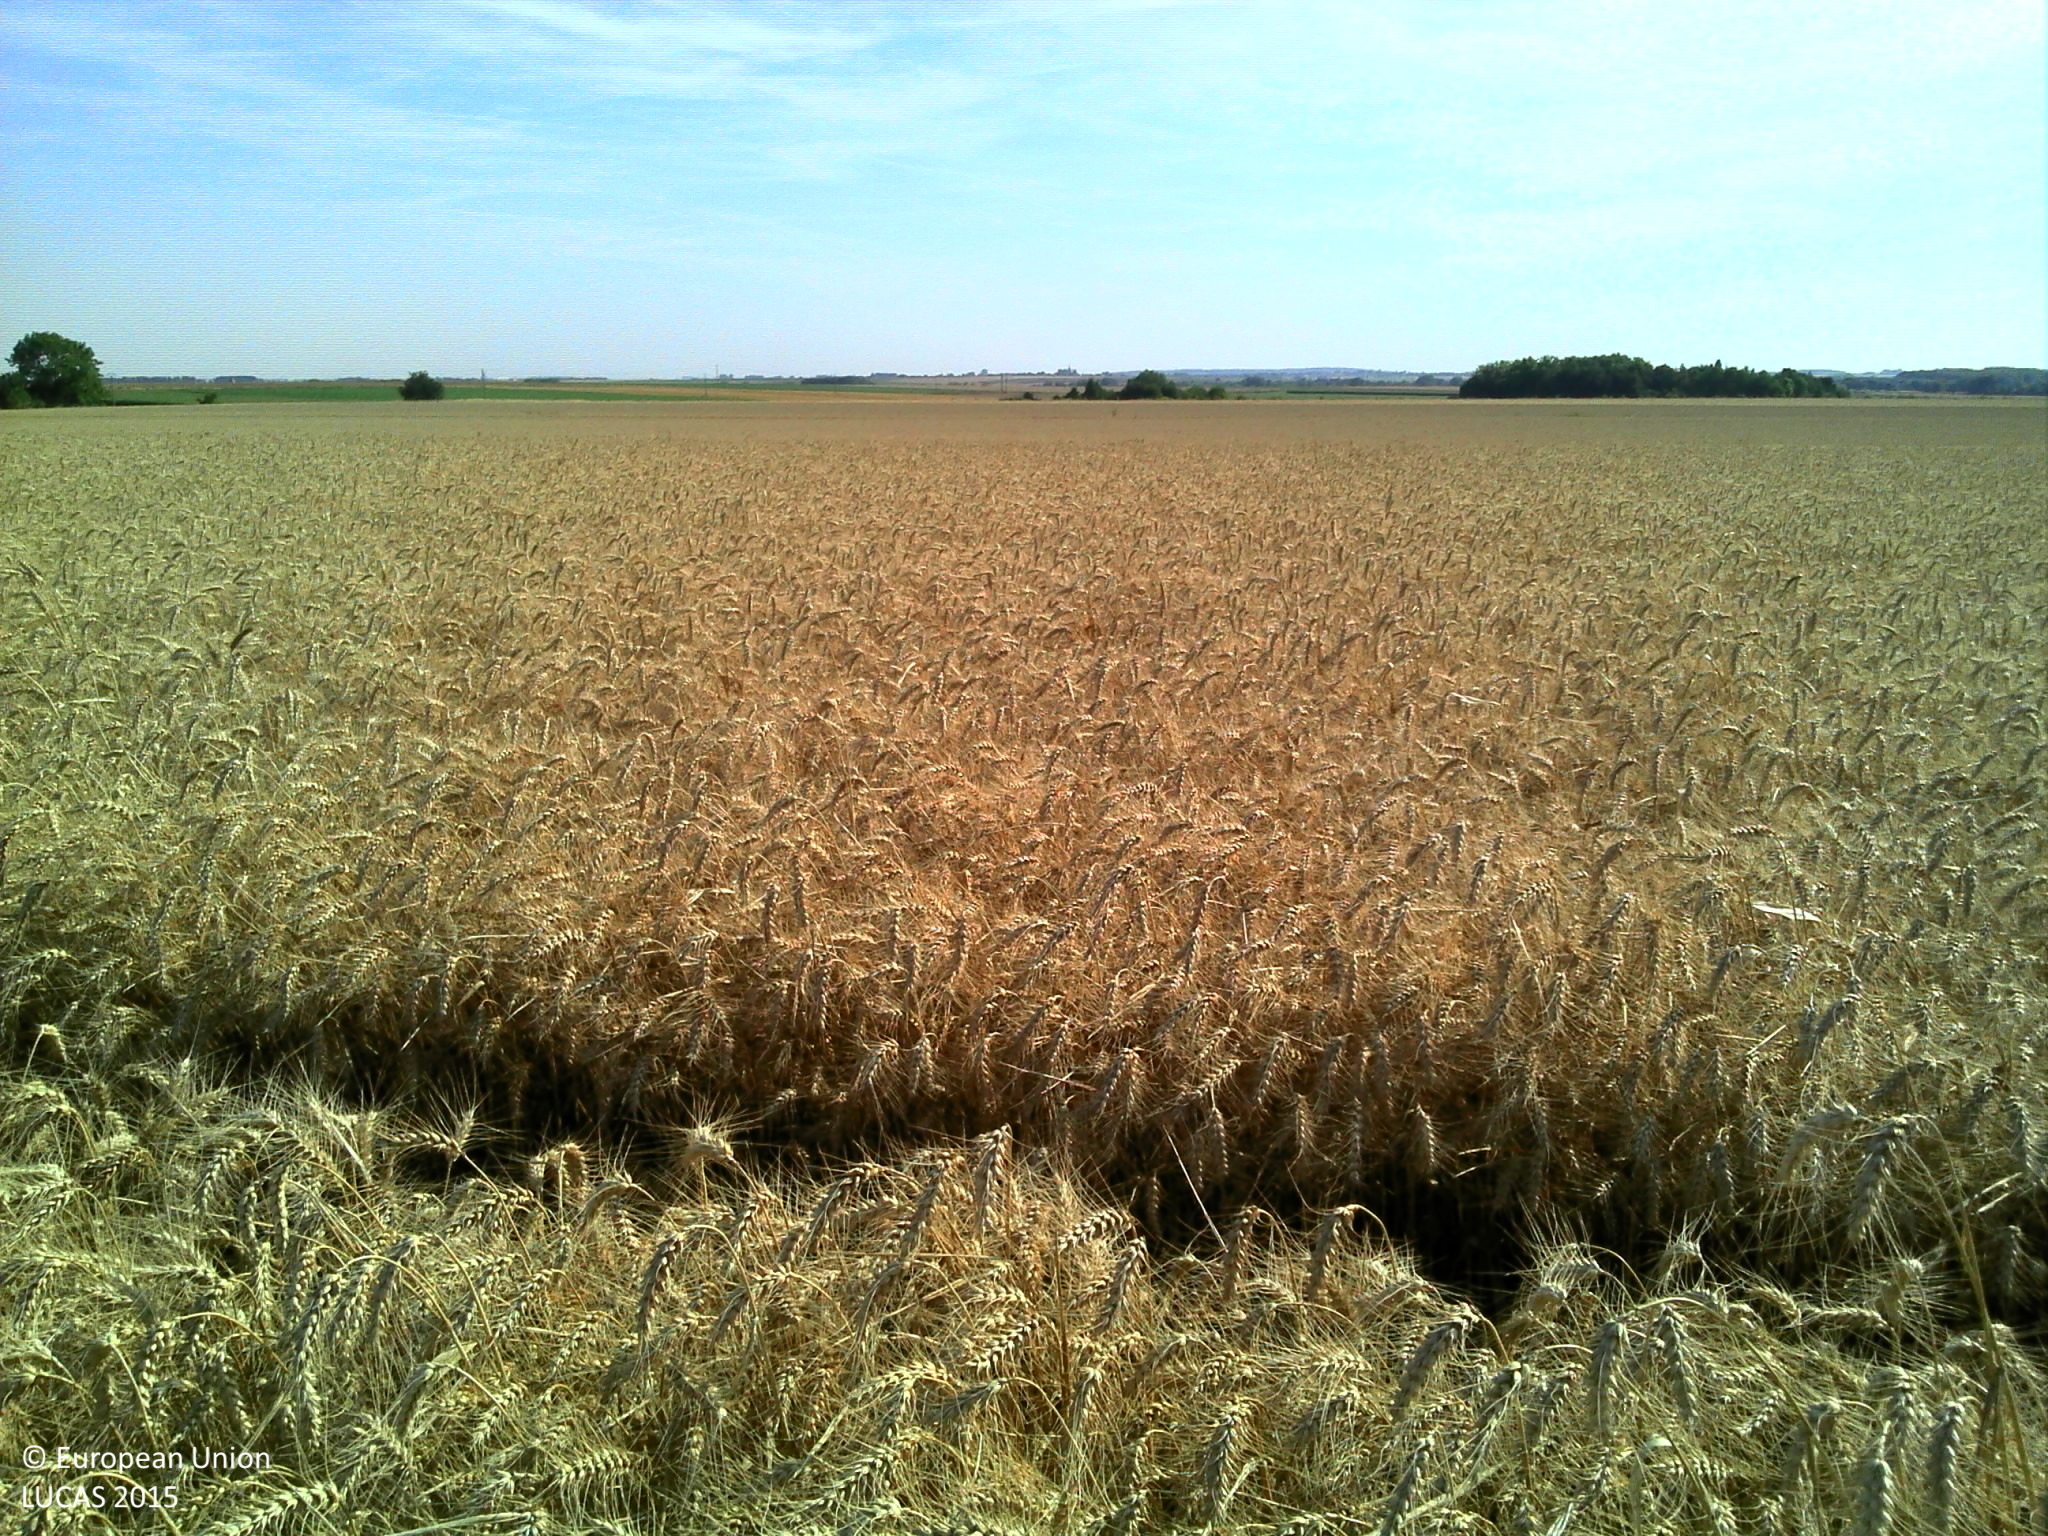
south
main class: Cropland
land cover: Common wheat
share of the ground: > 75 %
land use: Agriculture (excluding fallow land and kitchen gardens)
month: August
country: FR
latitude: 50.2870
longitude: 3.1839
